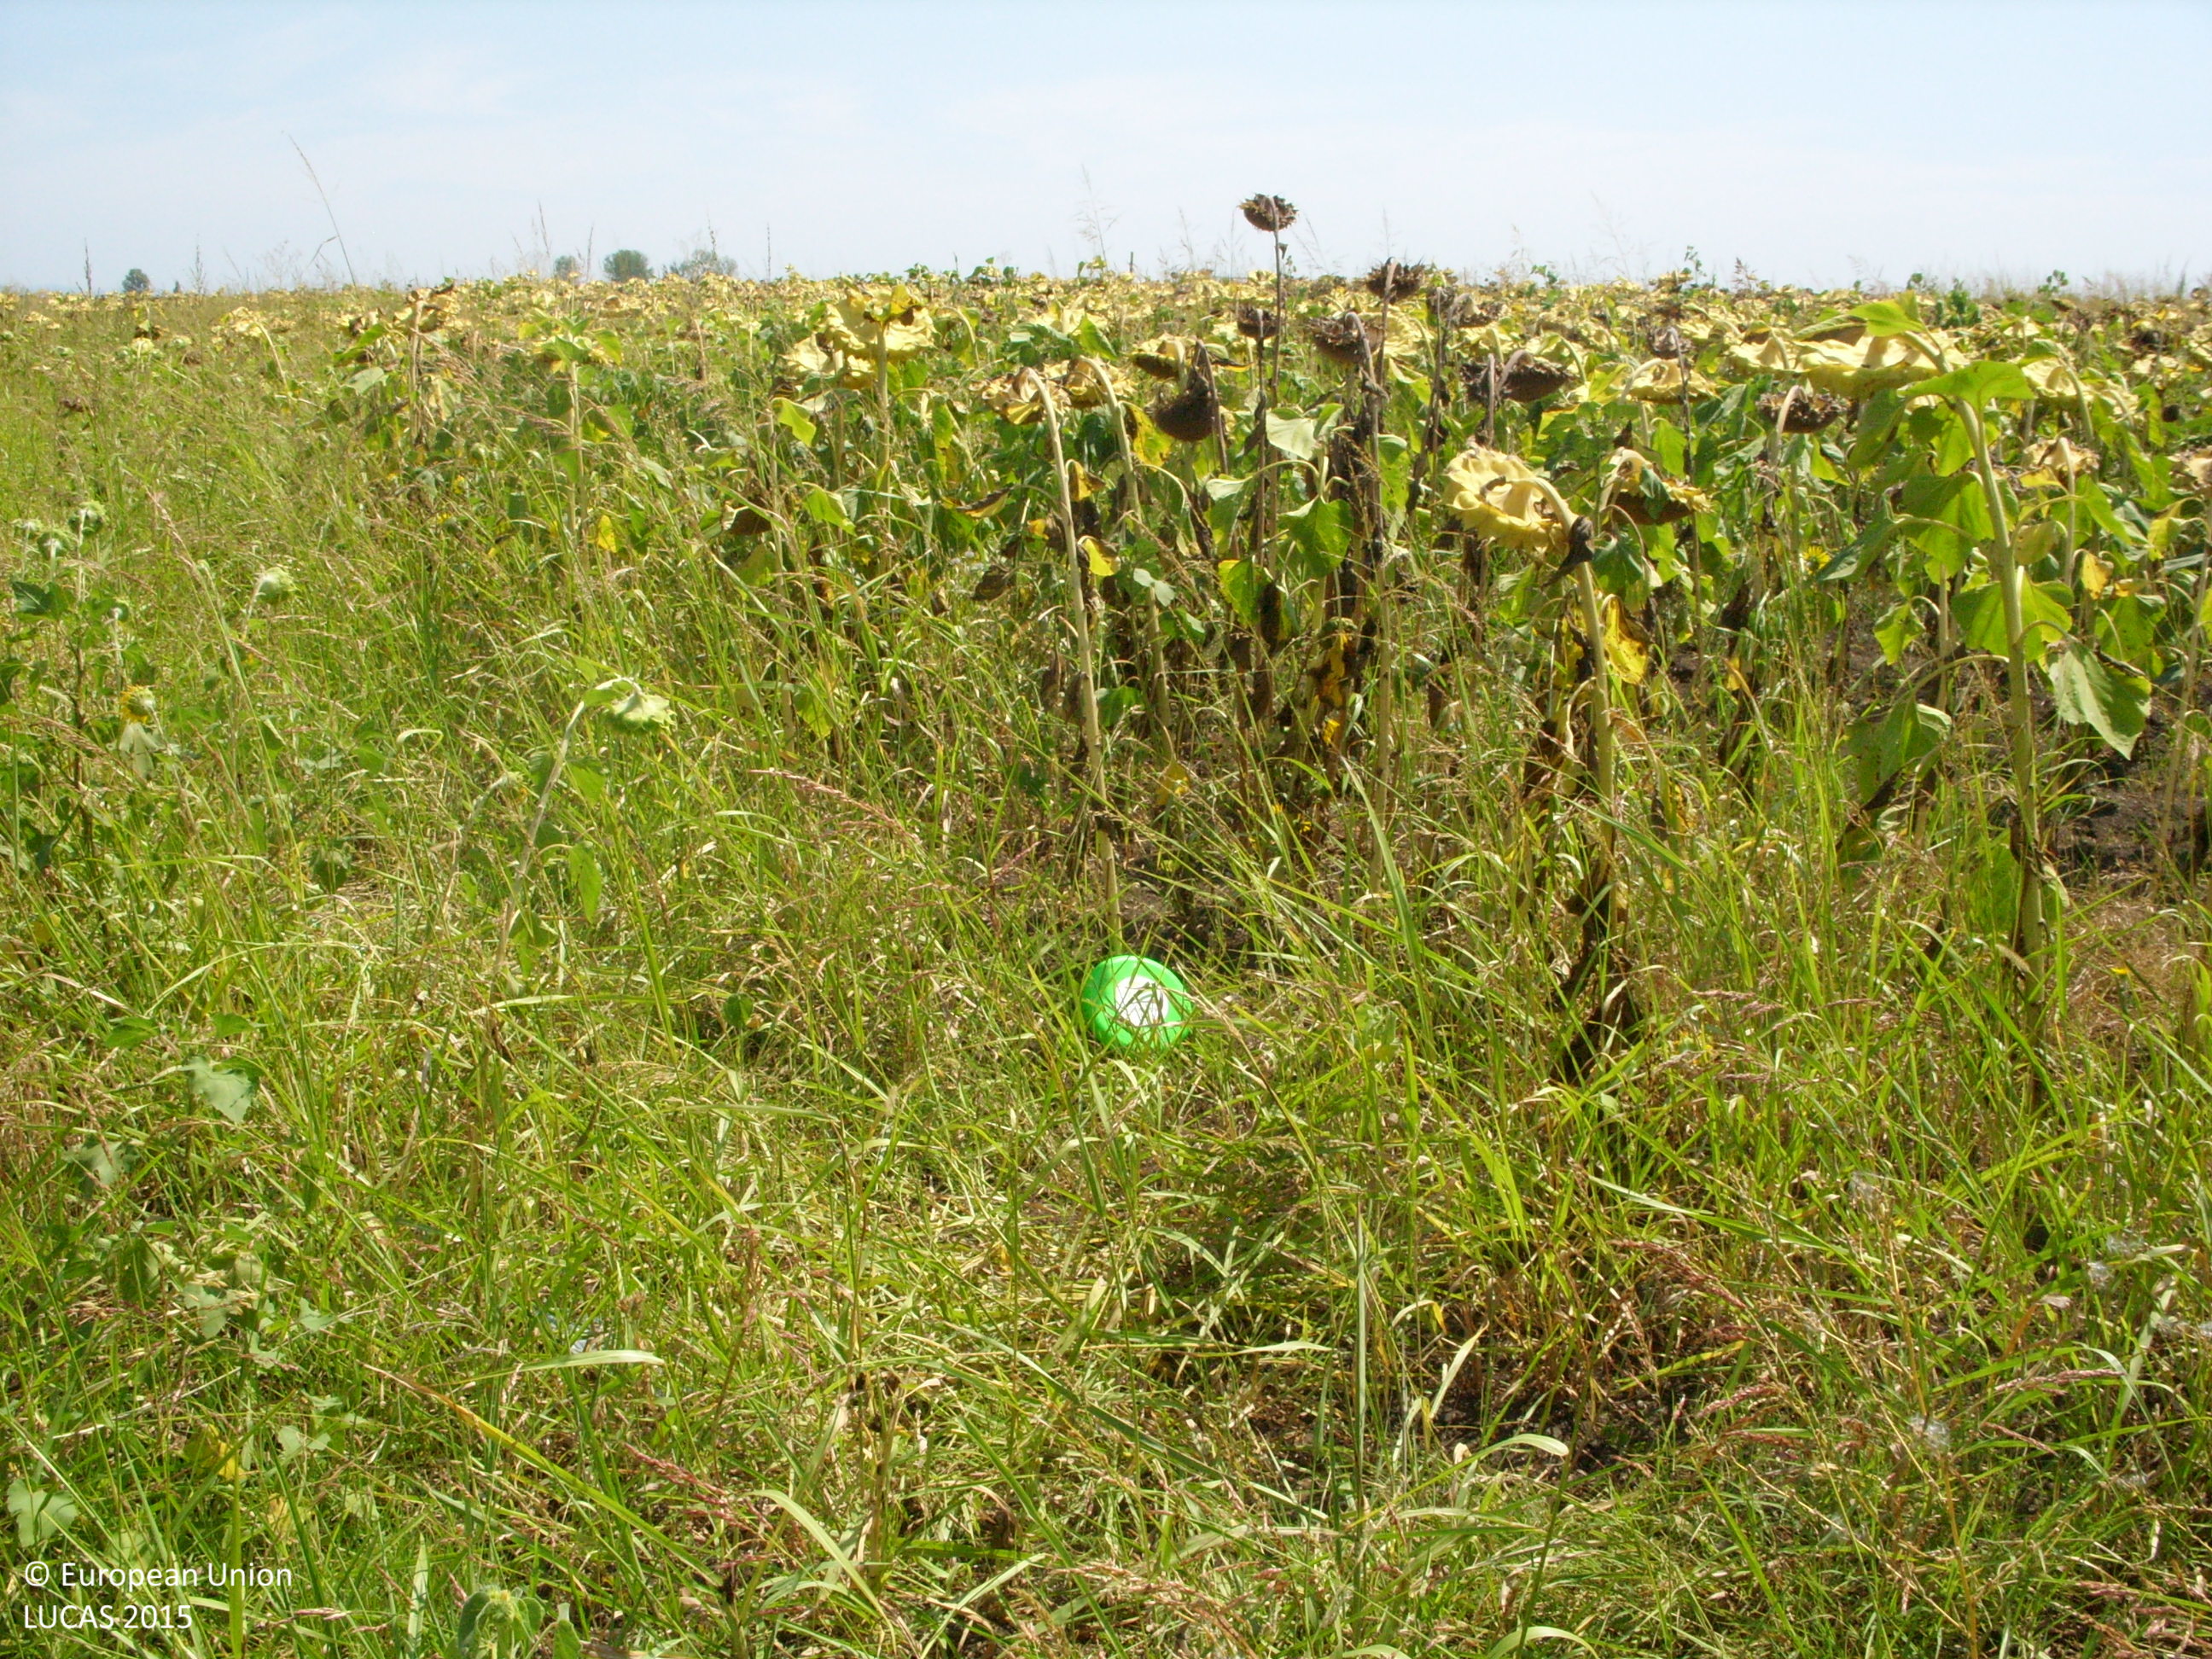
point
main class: Cropland
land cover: Sunflower
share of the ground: > 75 %
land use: Agriculture (excluding fallow land and kitchen gardens)
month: August
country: BG
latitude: 42.3048
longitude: 24.5954
